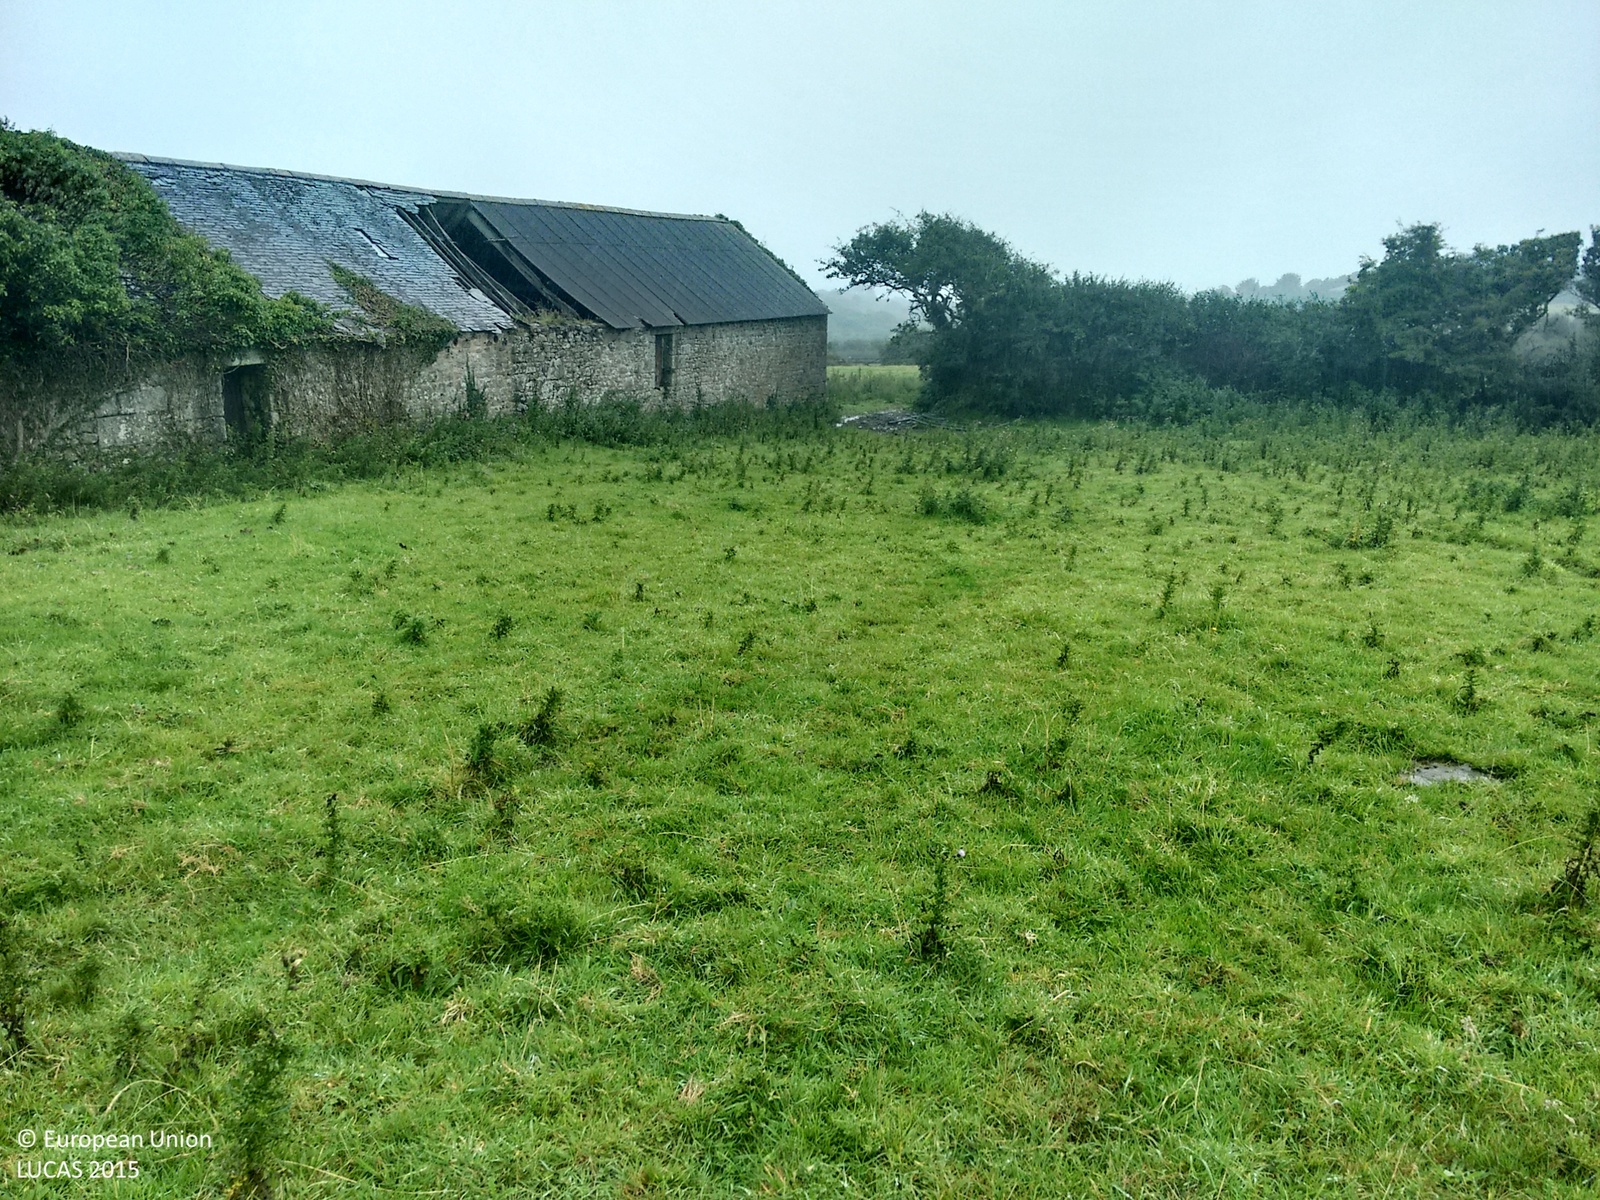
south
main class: Grassland
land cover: Grassland without tree/shrub cover
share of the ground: > 75 %
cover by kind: herbaceous plants 100 %
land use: Agriculture (excluding fallow land and kitchen gardens)
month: August
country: GB
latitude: 50.1255
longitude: -5.2131
